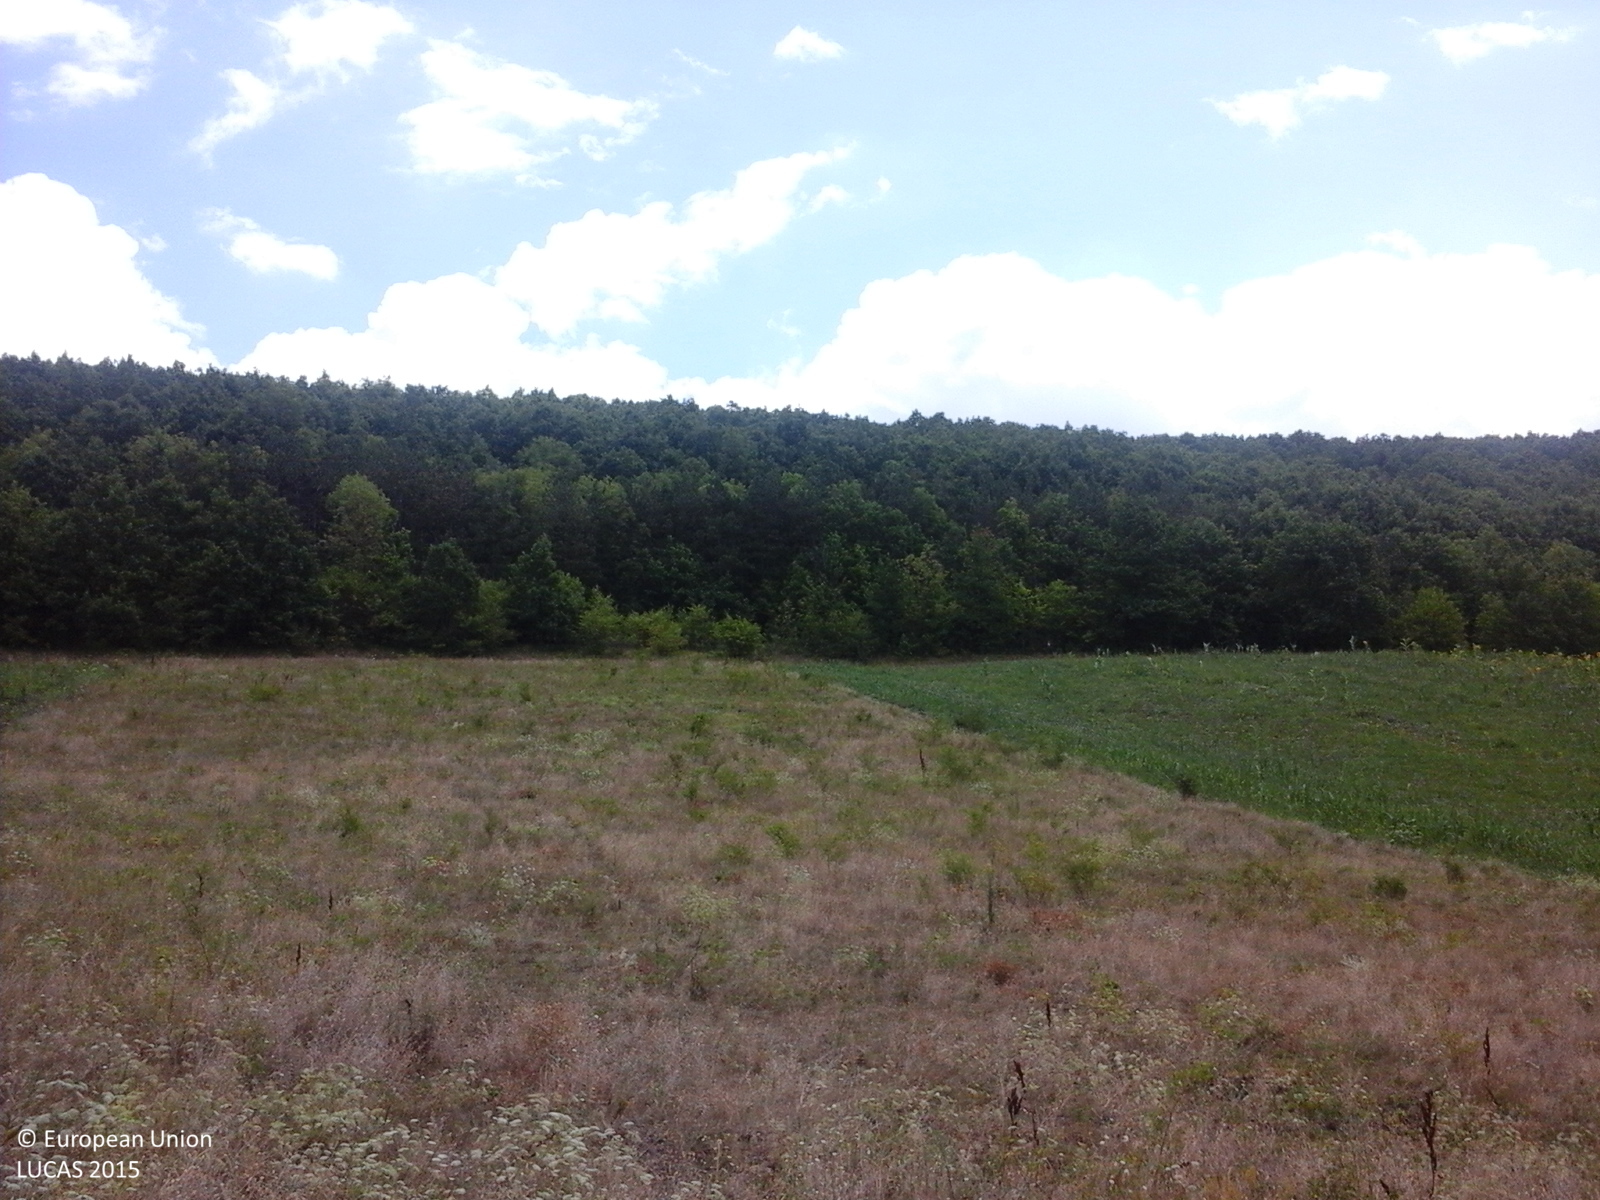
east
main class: Grassland
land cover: Spontaneously vegetated surfaces
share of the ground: > 75 %
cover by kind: herbaceous plants 100 %
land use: Fallow land
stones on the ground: < 10 %
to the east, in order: Spontaneously vegetated surfaces; Tracks; Grass margins; Broadleaved woodland
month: July
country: RO
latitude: 46.4596
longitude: 27.3853
